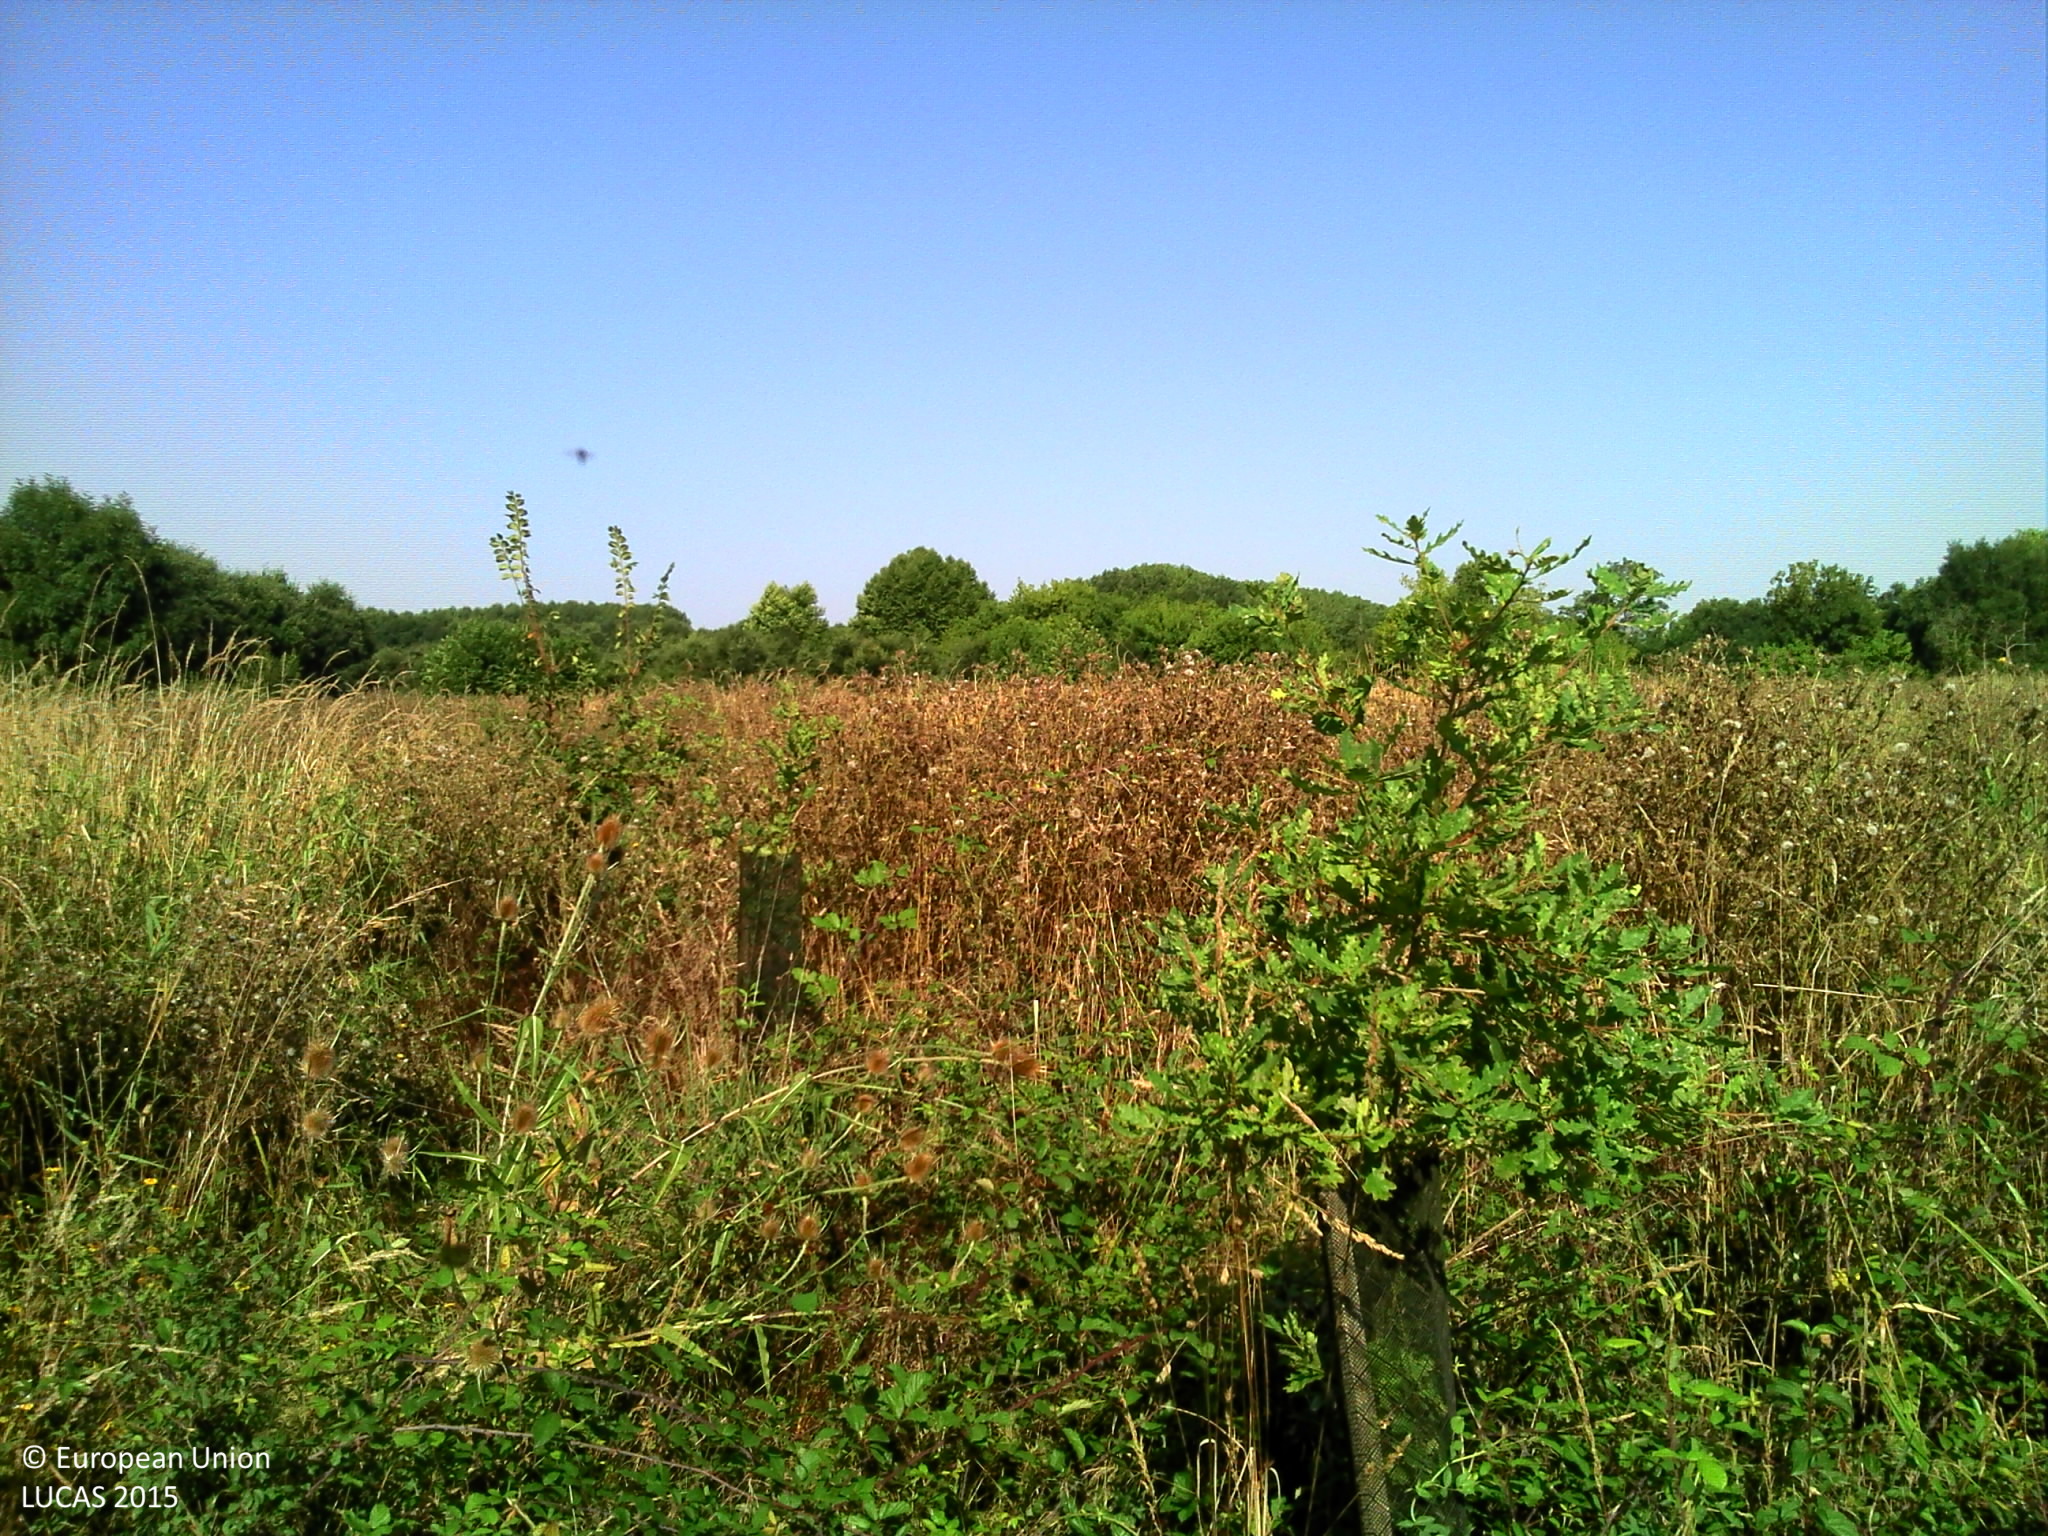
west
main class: Grassland
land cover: Grassland with sparse tree/shrub cover
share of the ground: > 75 %
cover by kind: herbaceous plants 95 %, broadleaved forest trees 5 %
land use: Forestry
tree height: < 5 m
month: August
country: FR
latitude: 43.7840
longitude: -0.8120
